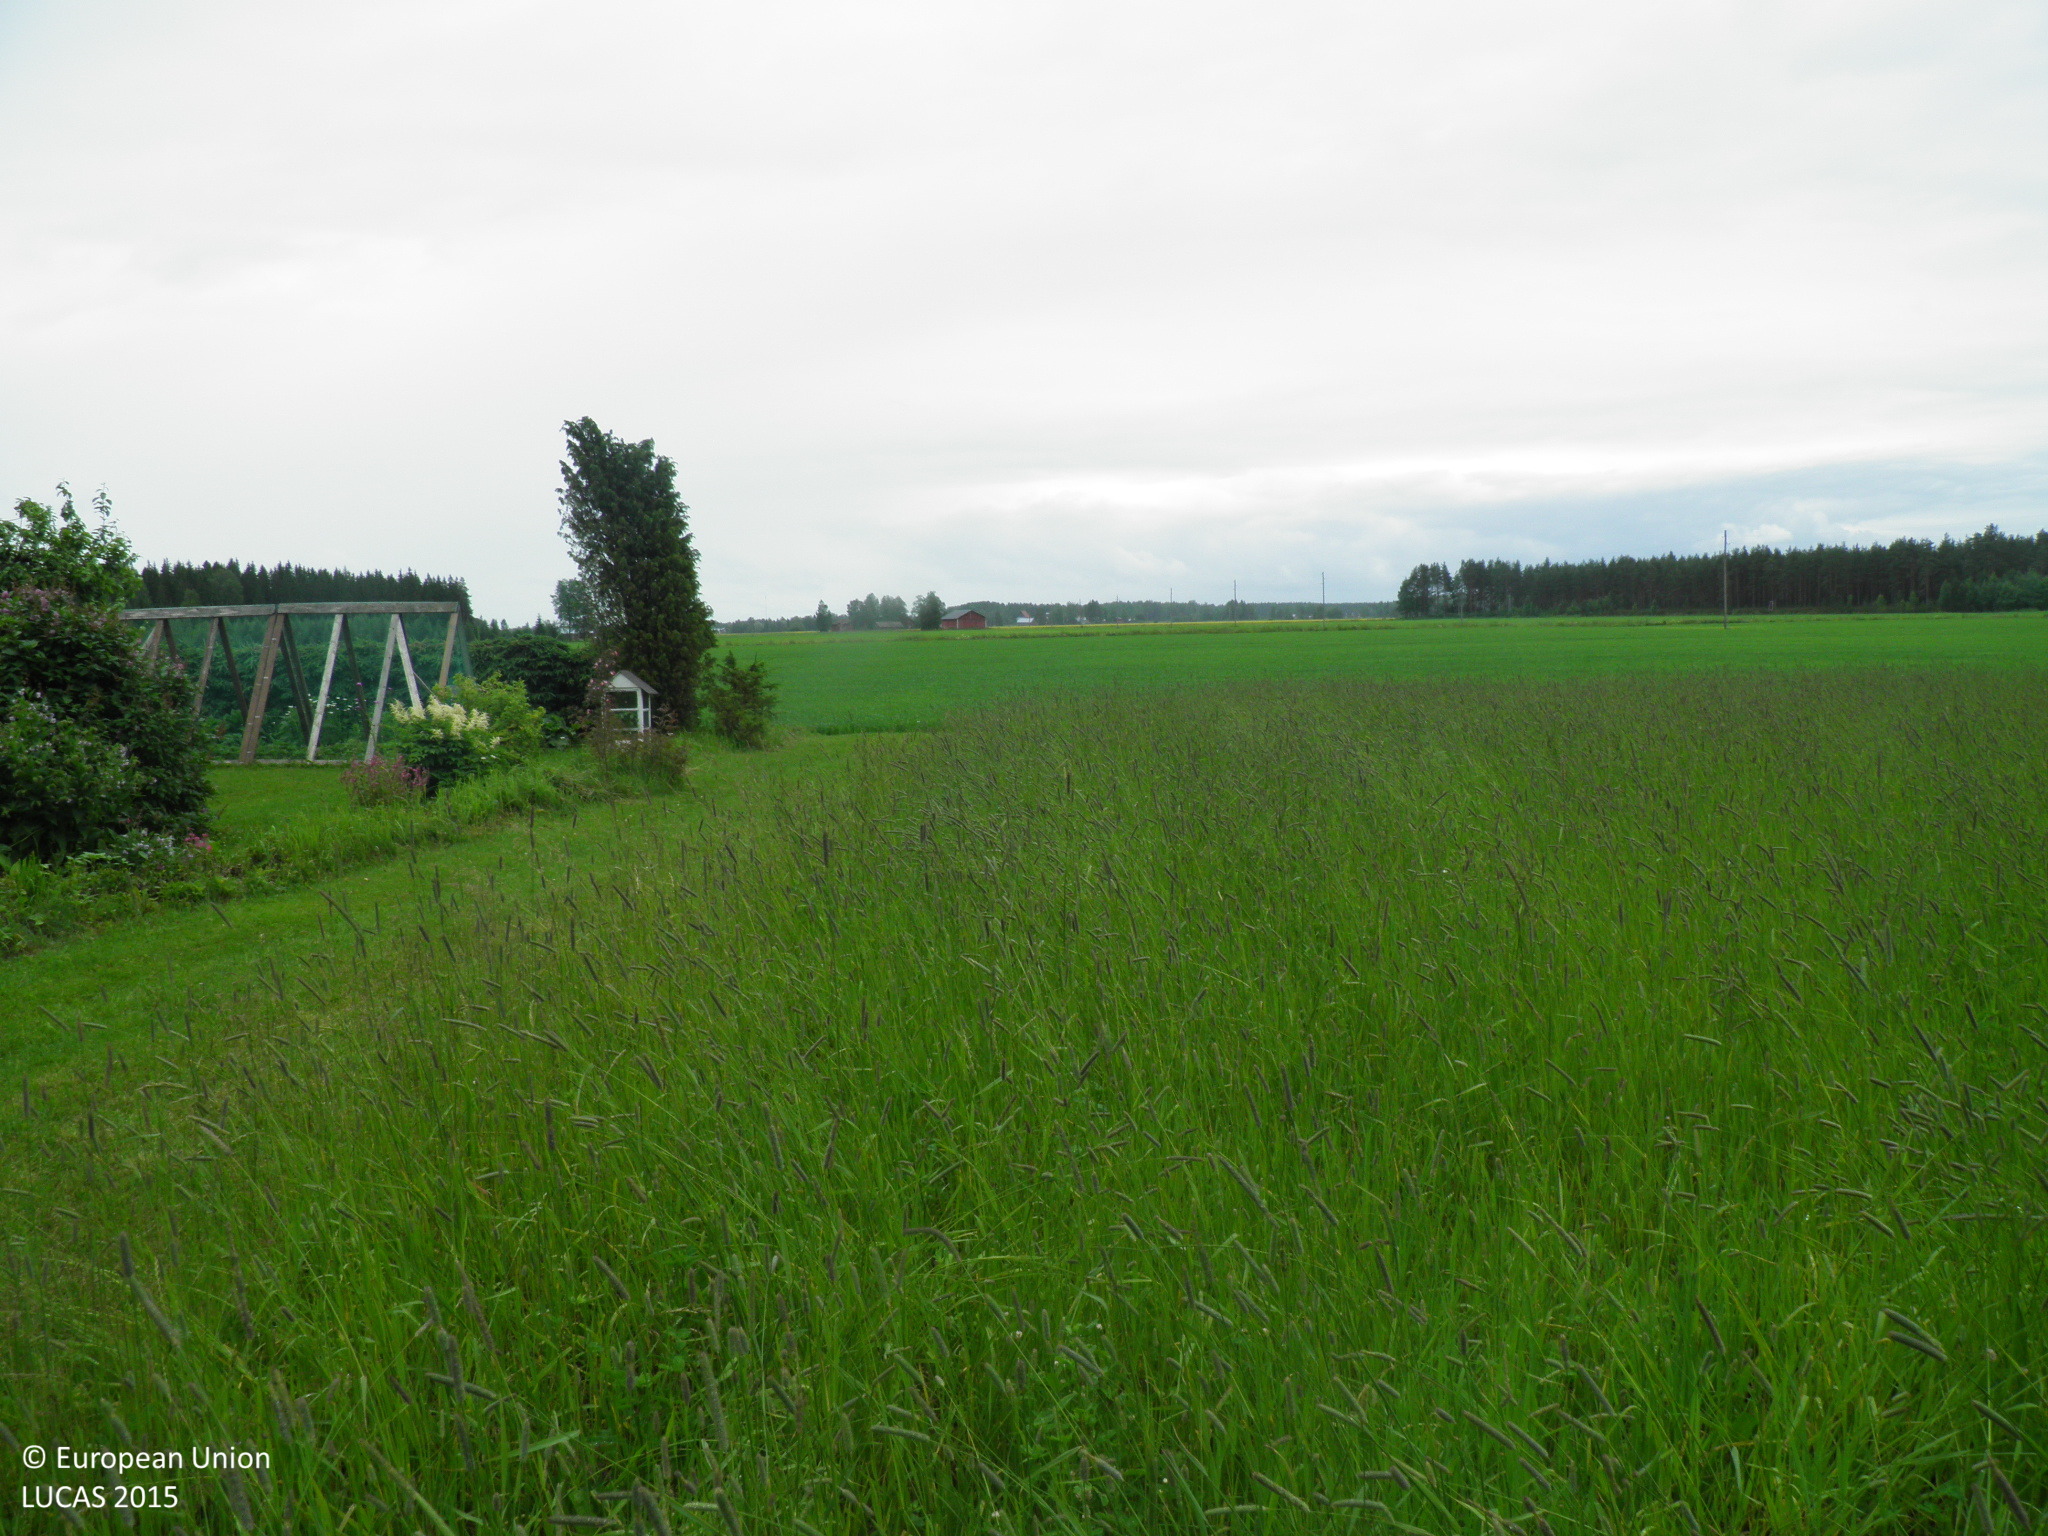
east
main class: Cropland
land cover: Temporary grasslands
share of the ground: > 75 %
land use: Agriculture (excluding fallow land and kitchen gardens)
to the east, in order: Temporary grasslands; Grassland without tree/shrub cover; Artificial constructions in urban areas; Common wheat; Ditches and canals; Artificial constructions in urban areas; Grassland without tree/shrub cover; Common wheat; Other bare soil
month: July
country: FI
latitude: 60.6844
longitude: 22.8732
